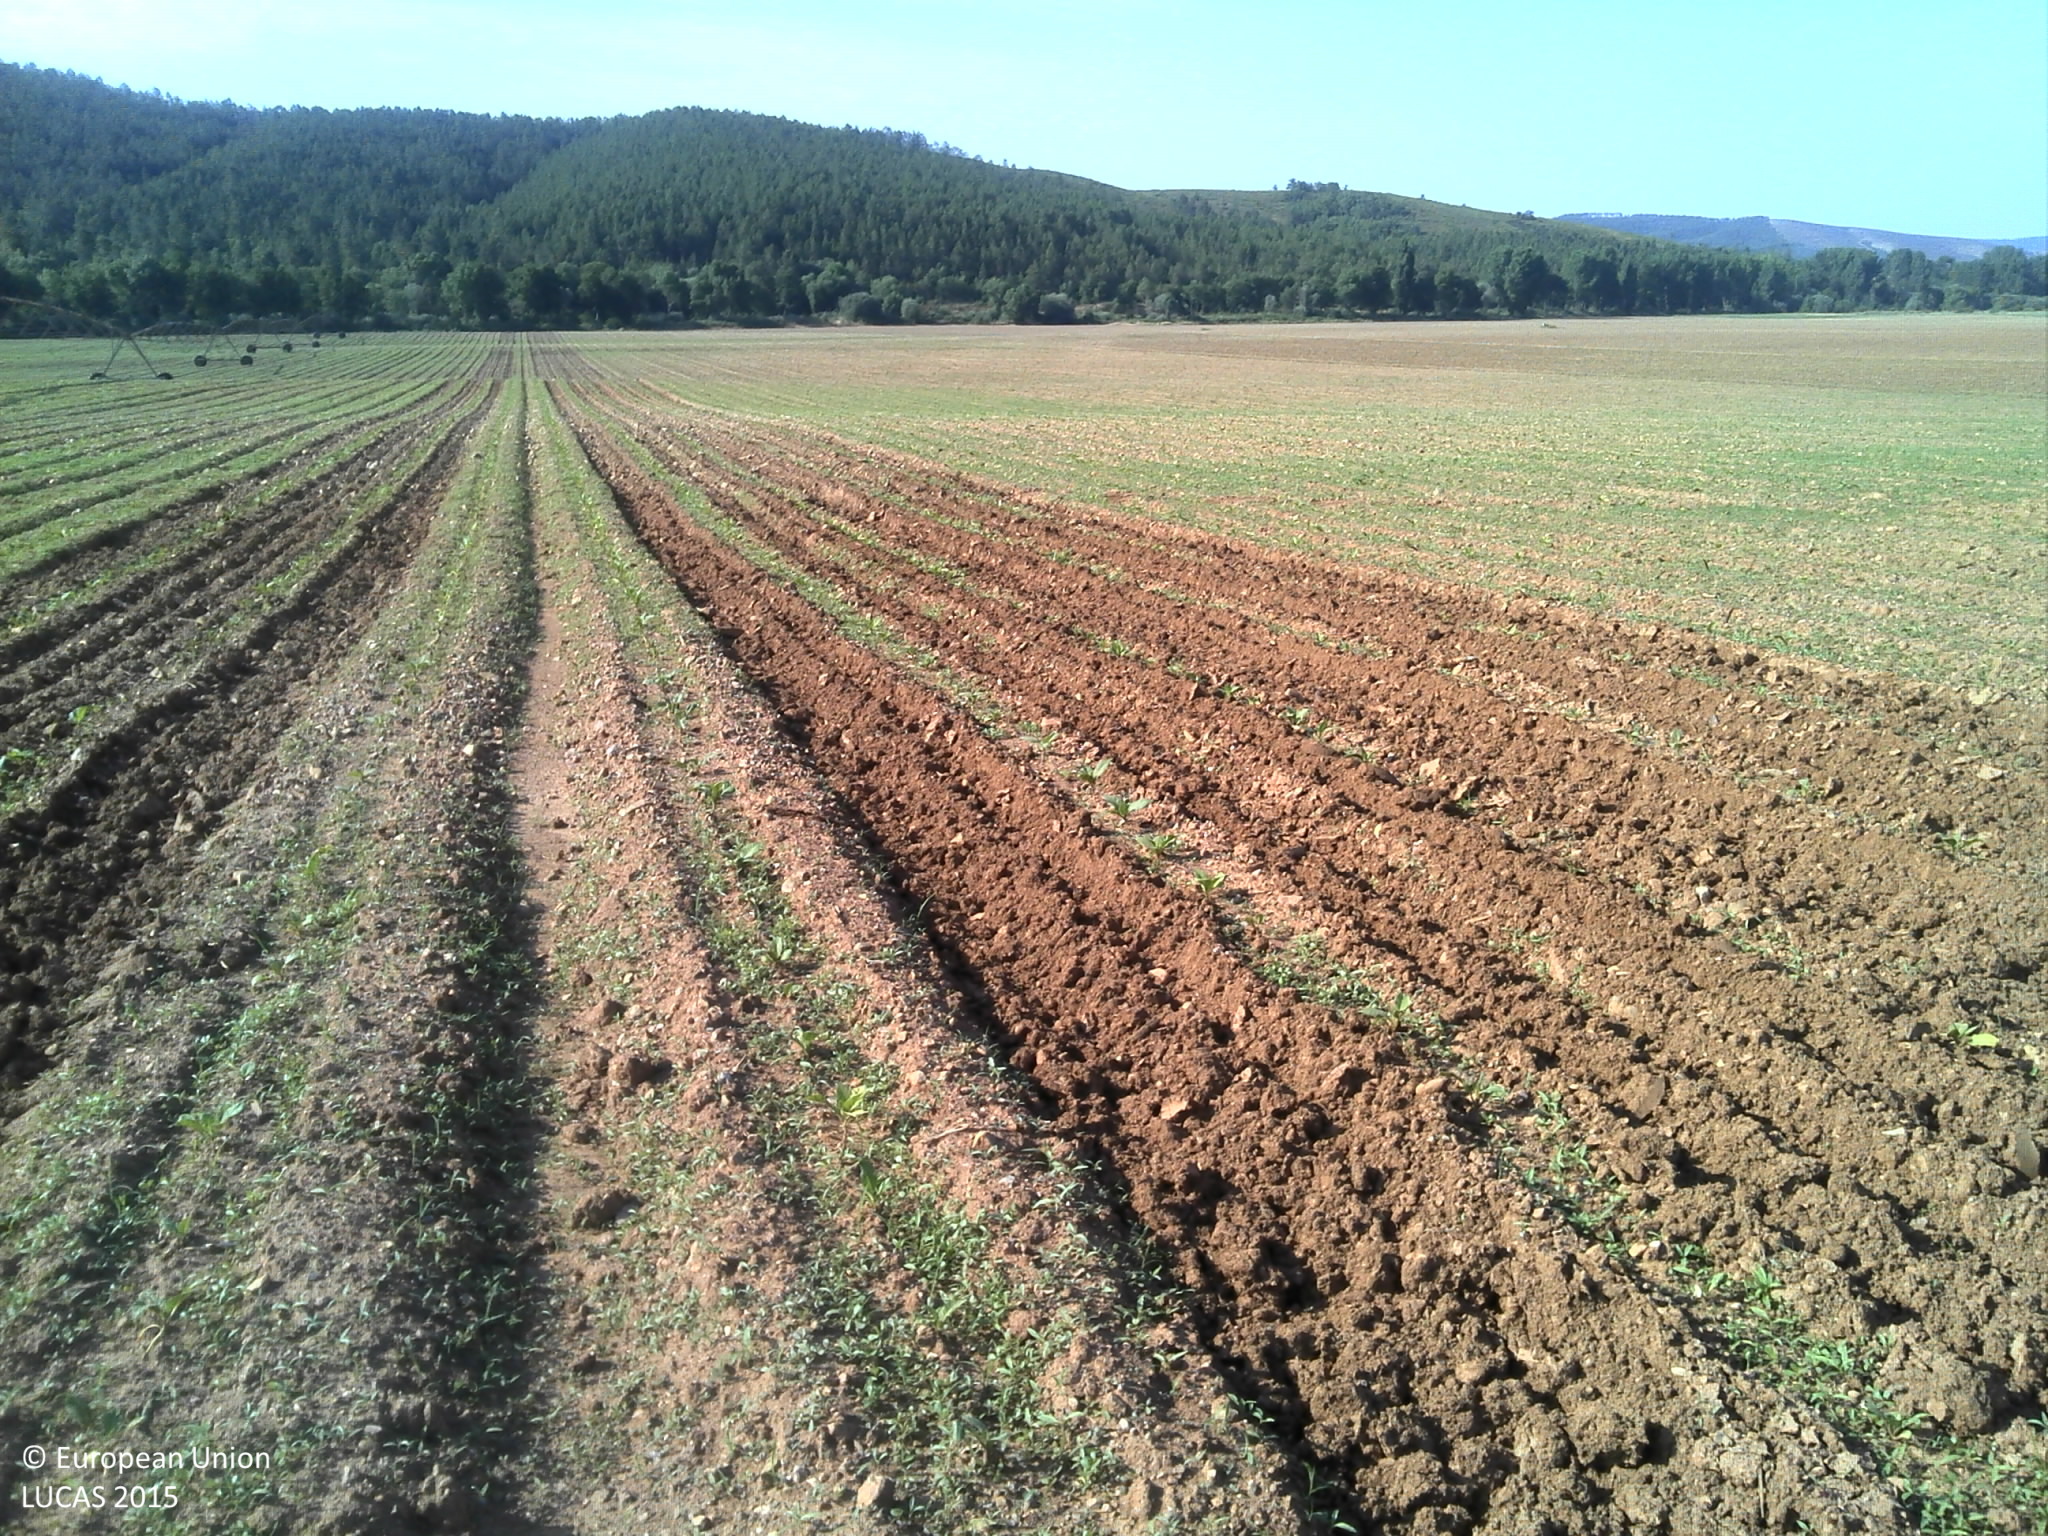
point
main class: Cropland
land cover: Tobacco
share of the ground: < 10 %
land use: Agriculture (excluding fallow land and kitchen gardens)
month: June
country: PT
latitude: 40.2051
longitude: -7.3369
